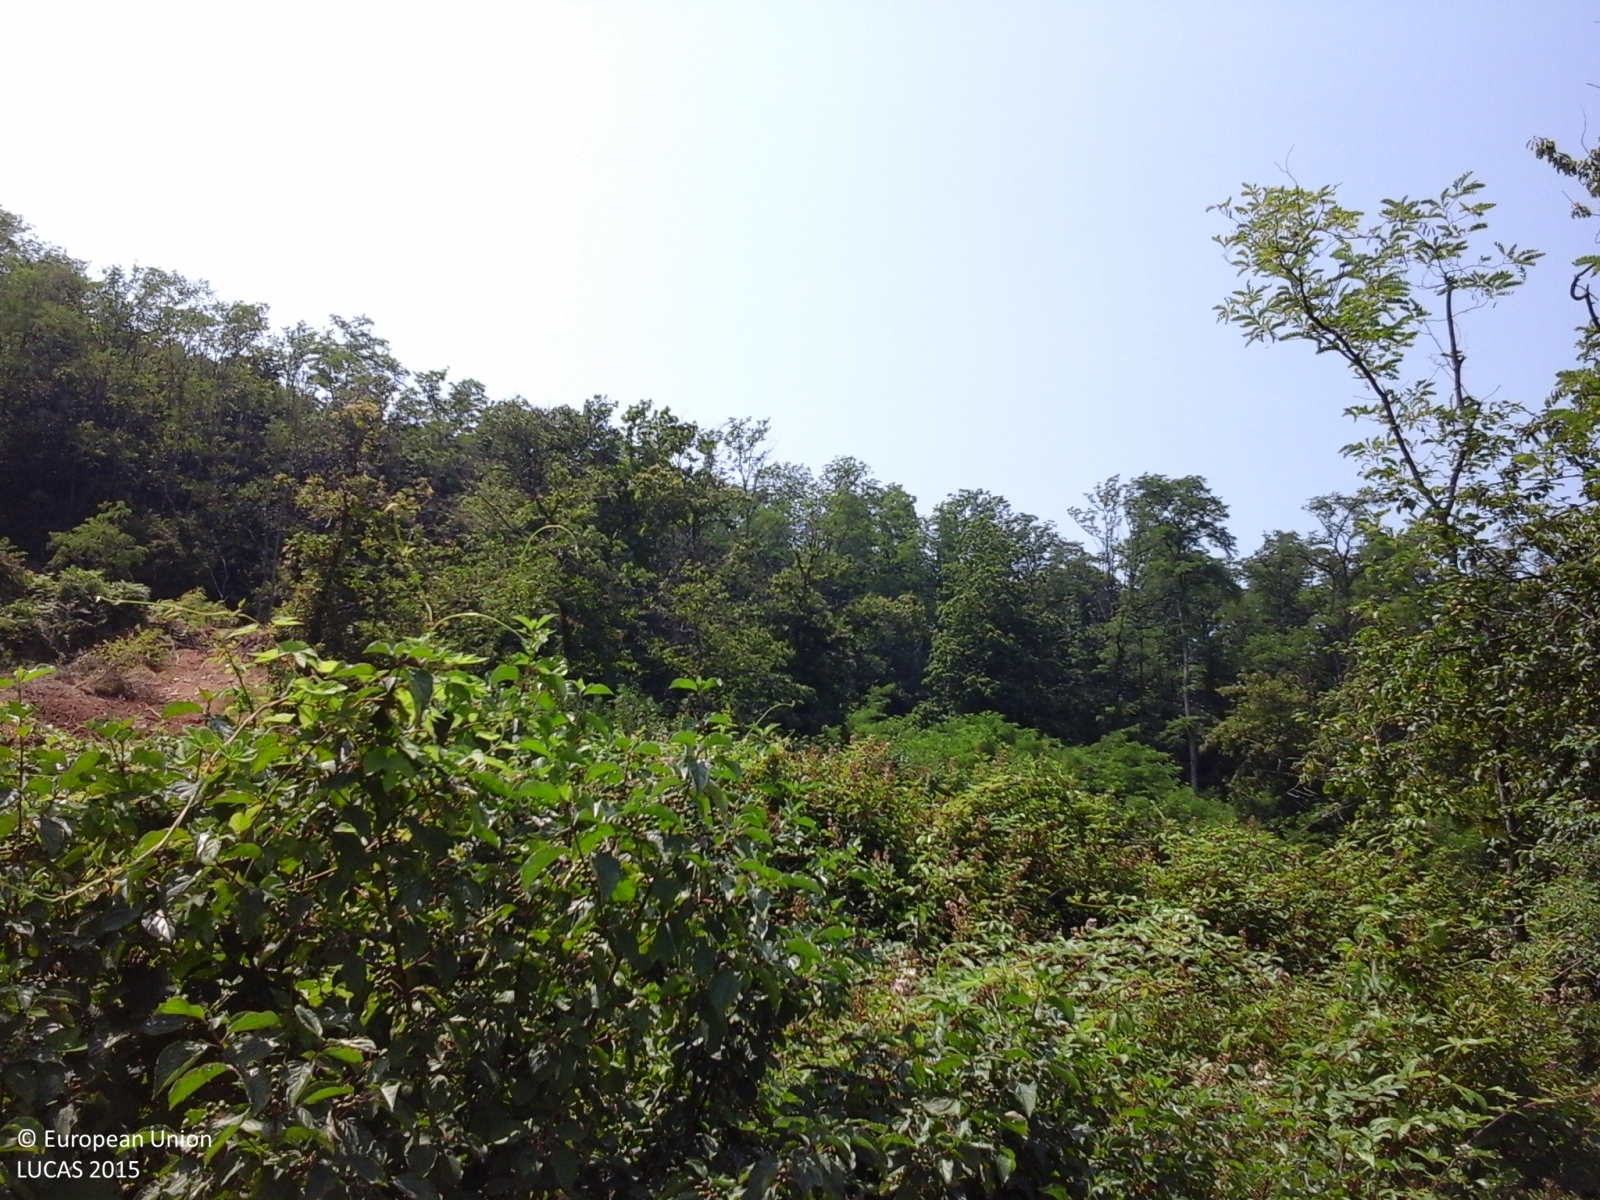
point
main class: Woodland
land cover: Broadleaved woodland
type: thermophilous deciduous forest
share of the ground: > 75 %
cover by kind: broadleaved forest trees 100 %
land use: Forestry
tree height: > 5 m
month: July
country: IT
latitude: 44.7044
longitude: 8.8035
